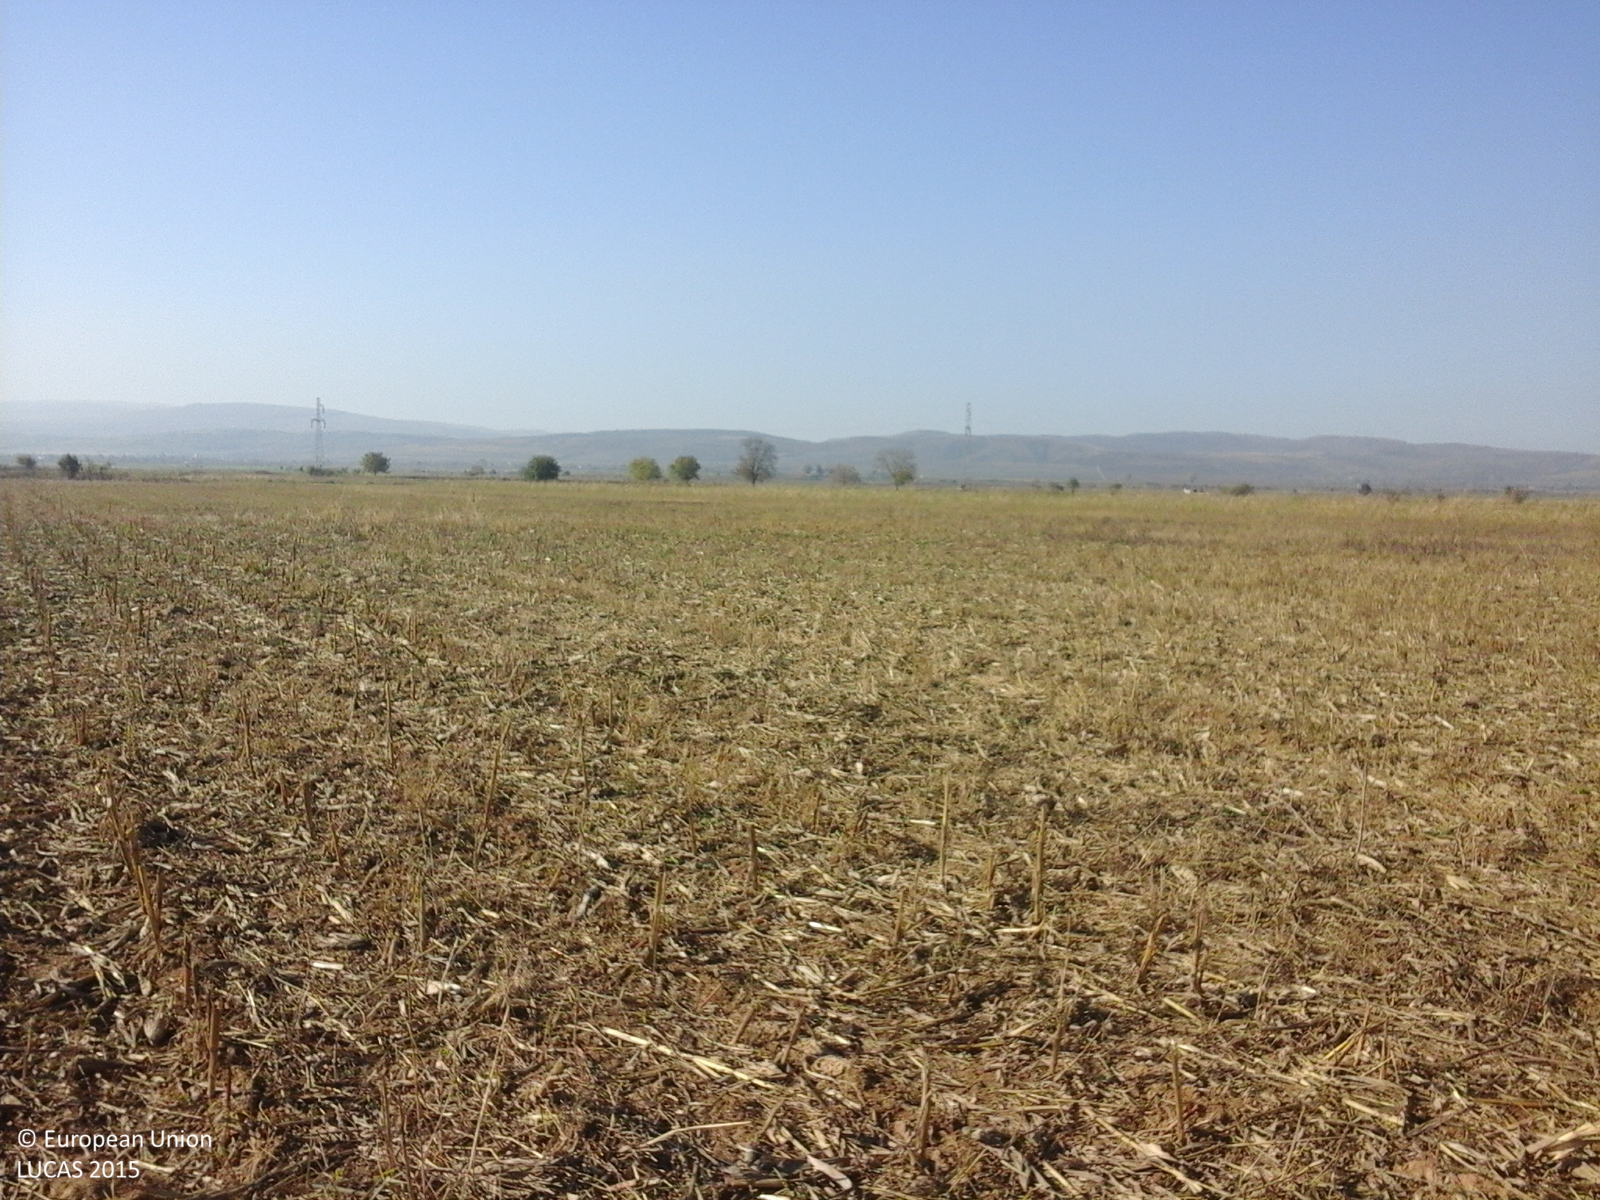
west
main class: Cropland
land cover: Maize
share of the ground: < 10 %
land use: Agriculture (excluding fallow land and kitchen gardens)
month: October
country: RO
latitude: 45.1332
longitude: 26.7214
